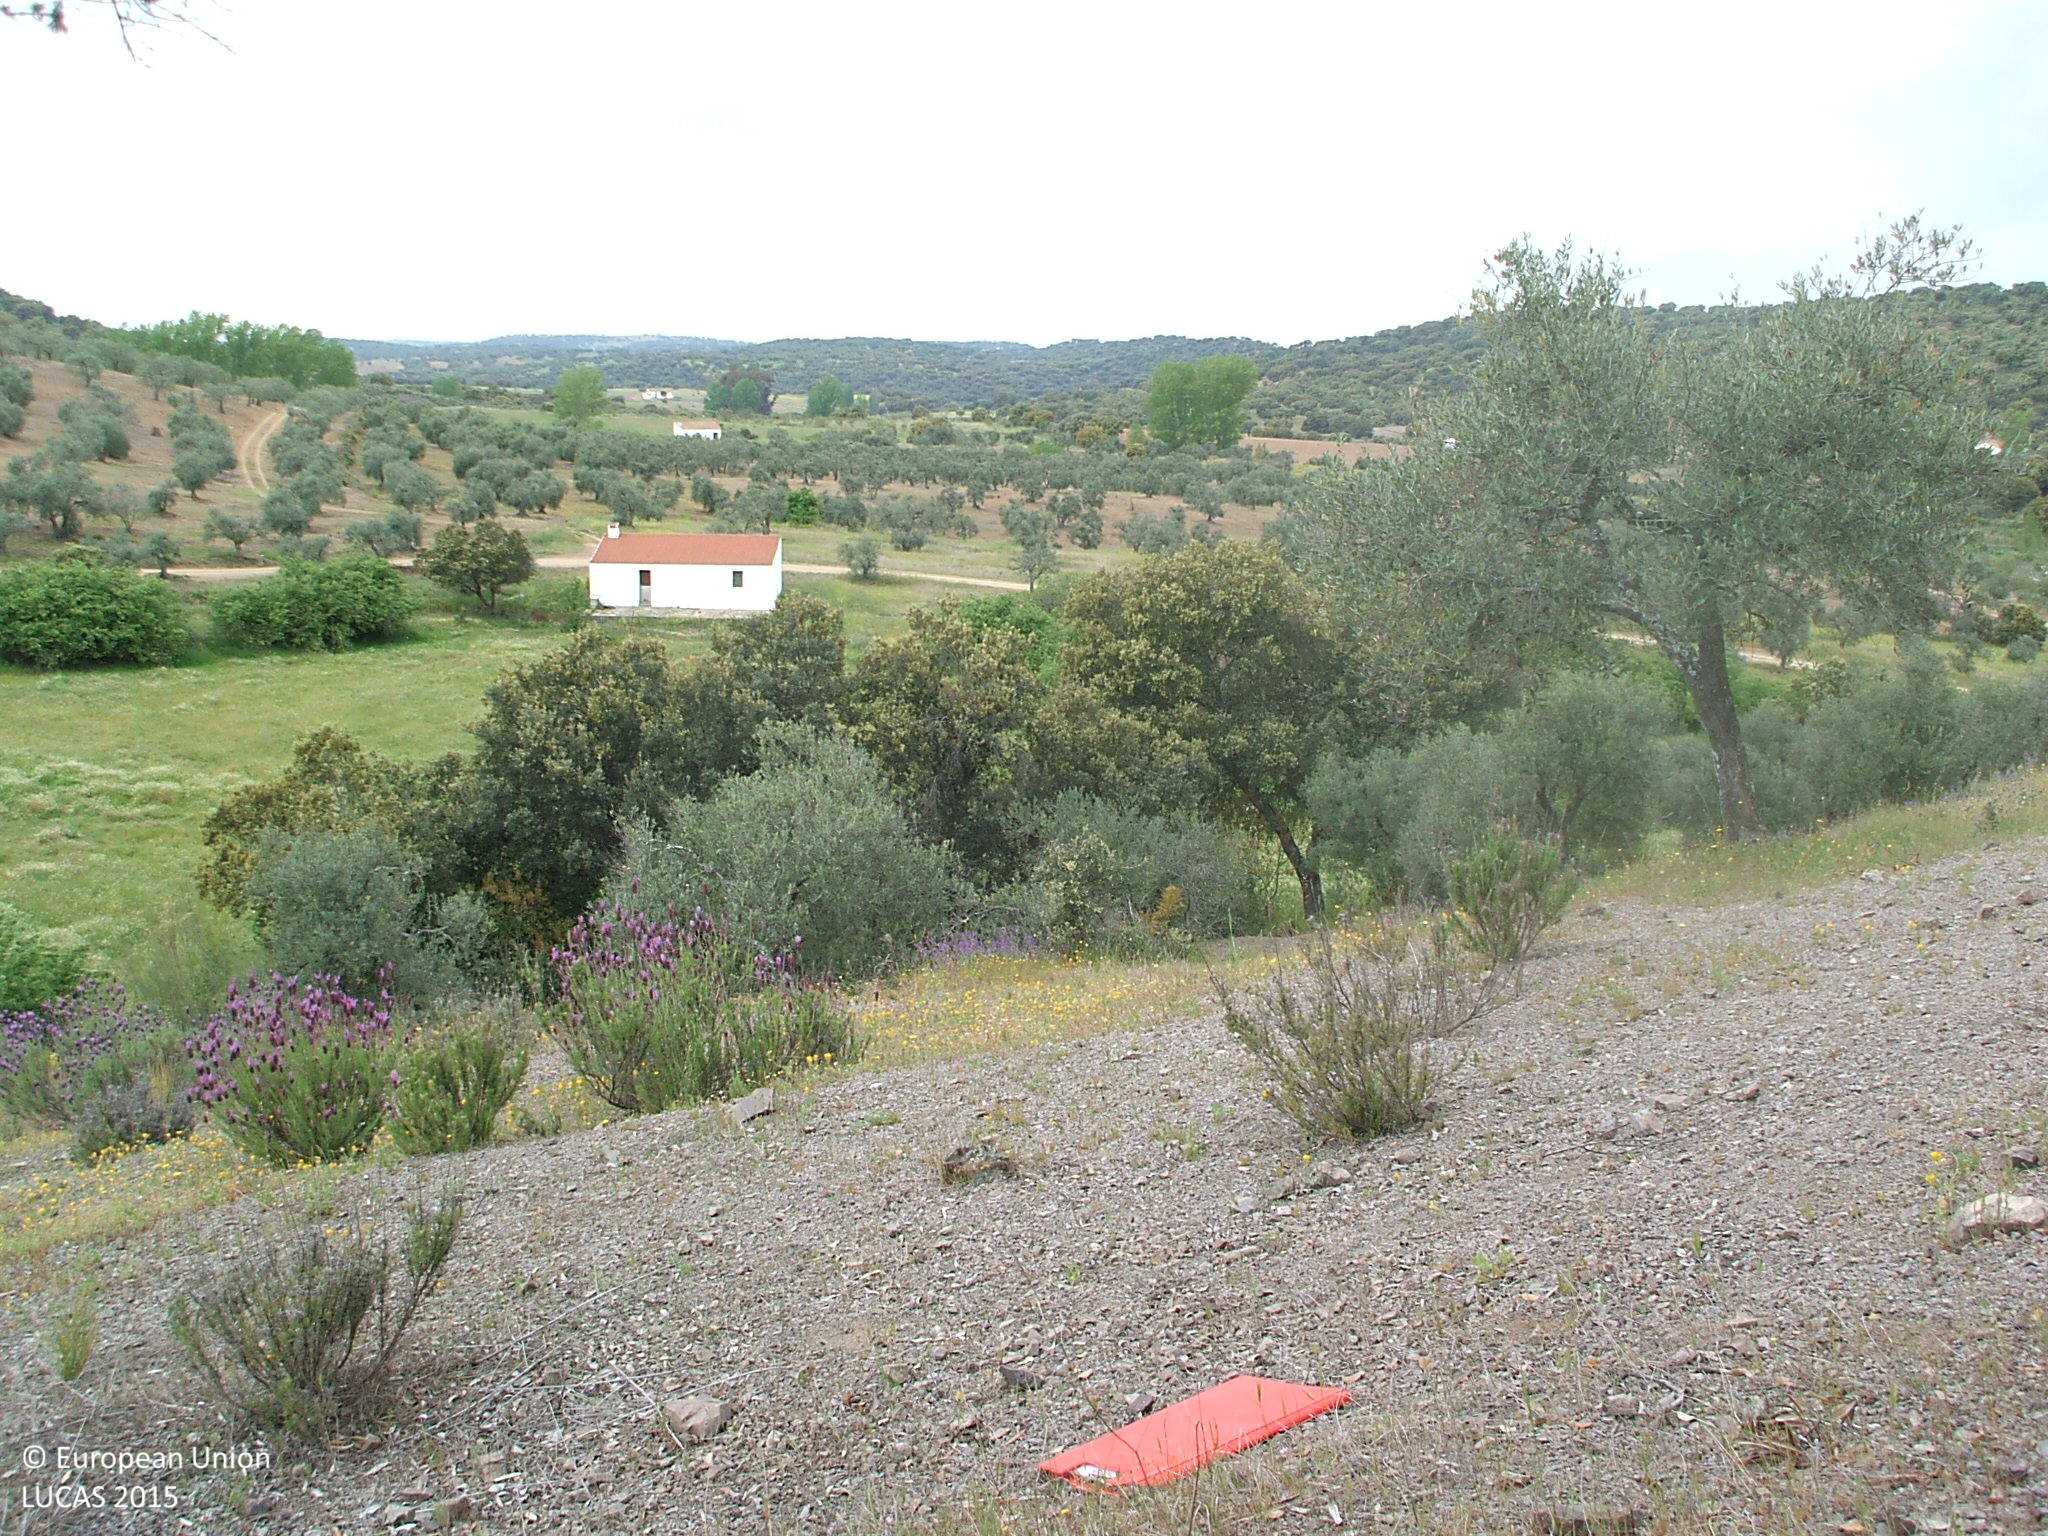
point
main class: Cropland
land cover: Olive groves
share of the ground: 10 - 25 %
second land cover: Shrubland without tree cover
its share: 10 - 25 %
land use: Agriculture (excluding fallow land and kitchen gardens)
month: April
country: ES
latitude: 38.1265
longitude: -5.7181
